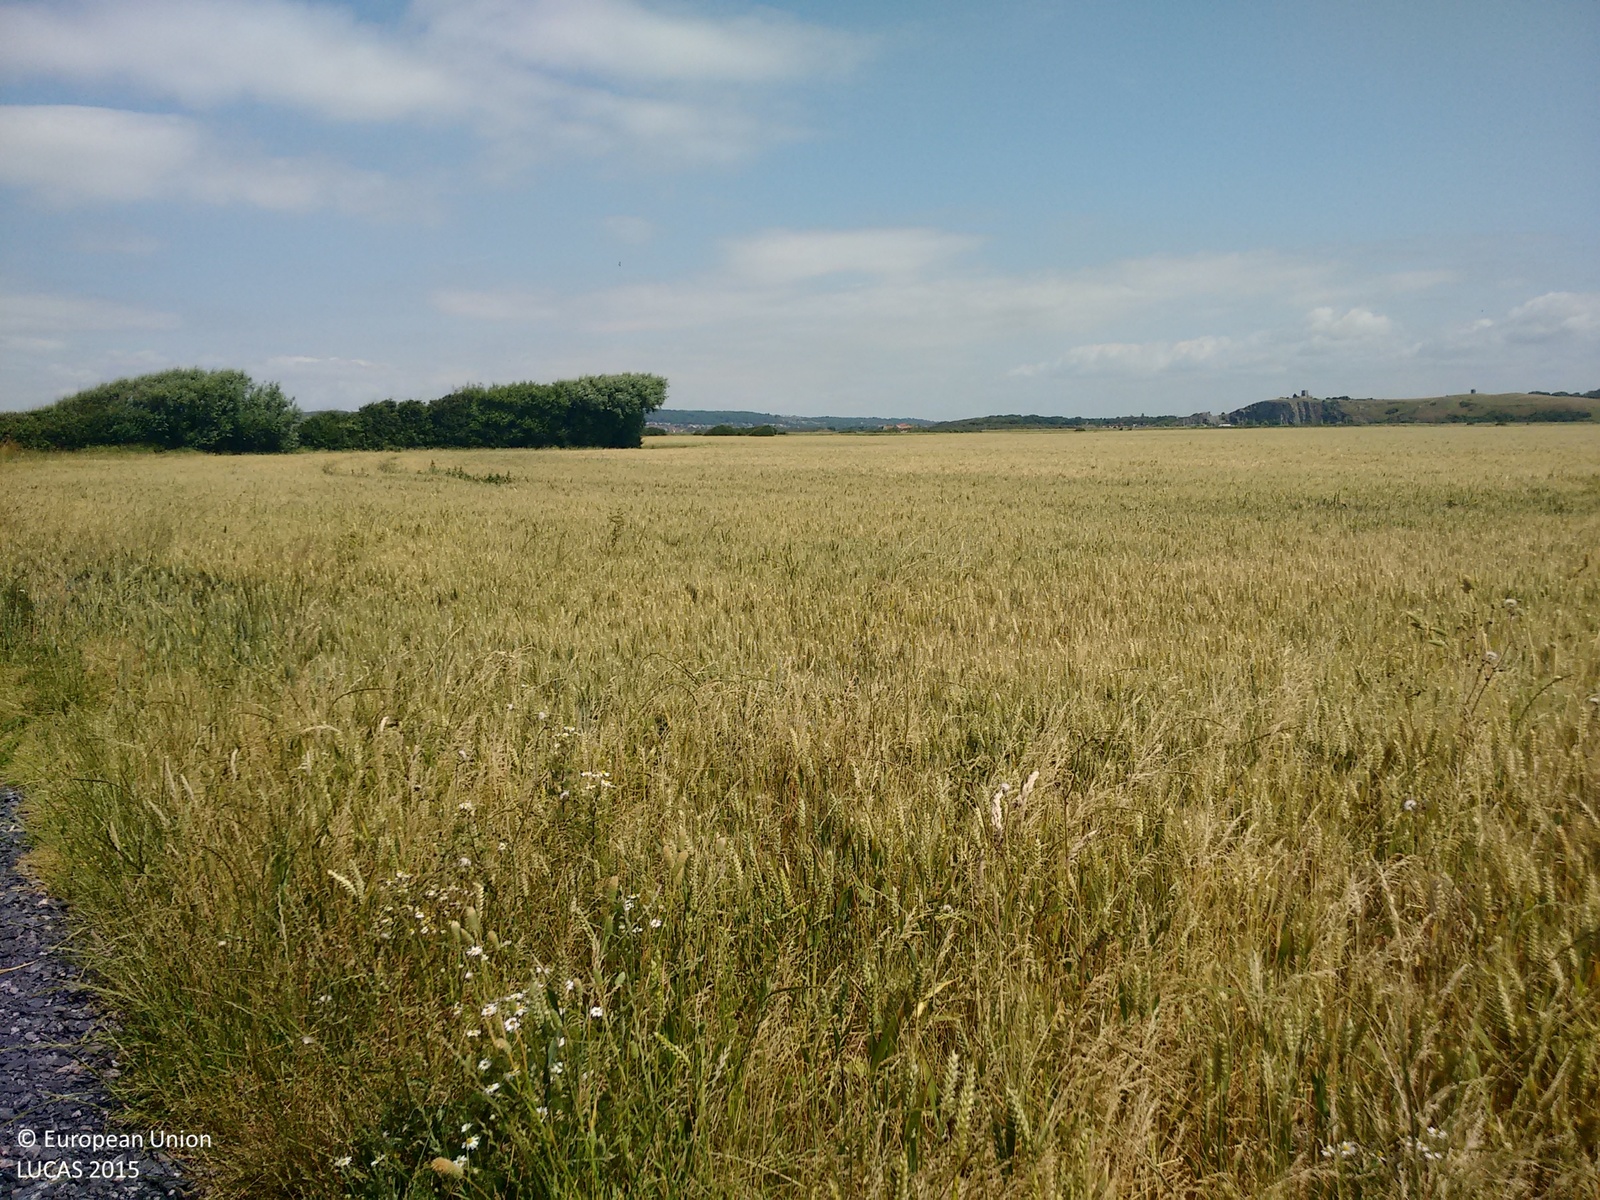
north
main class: Cropland
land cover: Common wheat
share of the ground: > 75 %
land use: Agriculture (excluding fallow land and kitchen gardens)
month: July
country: GB
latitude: 51.3124
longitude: -3.0013
